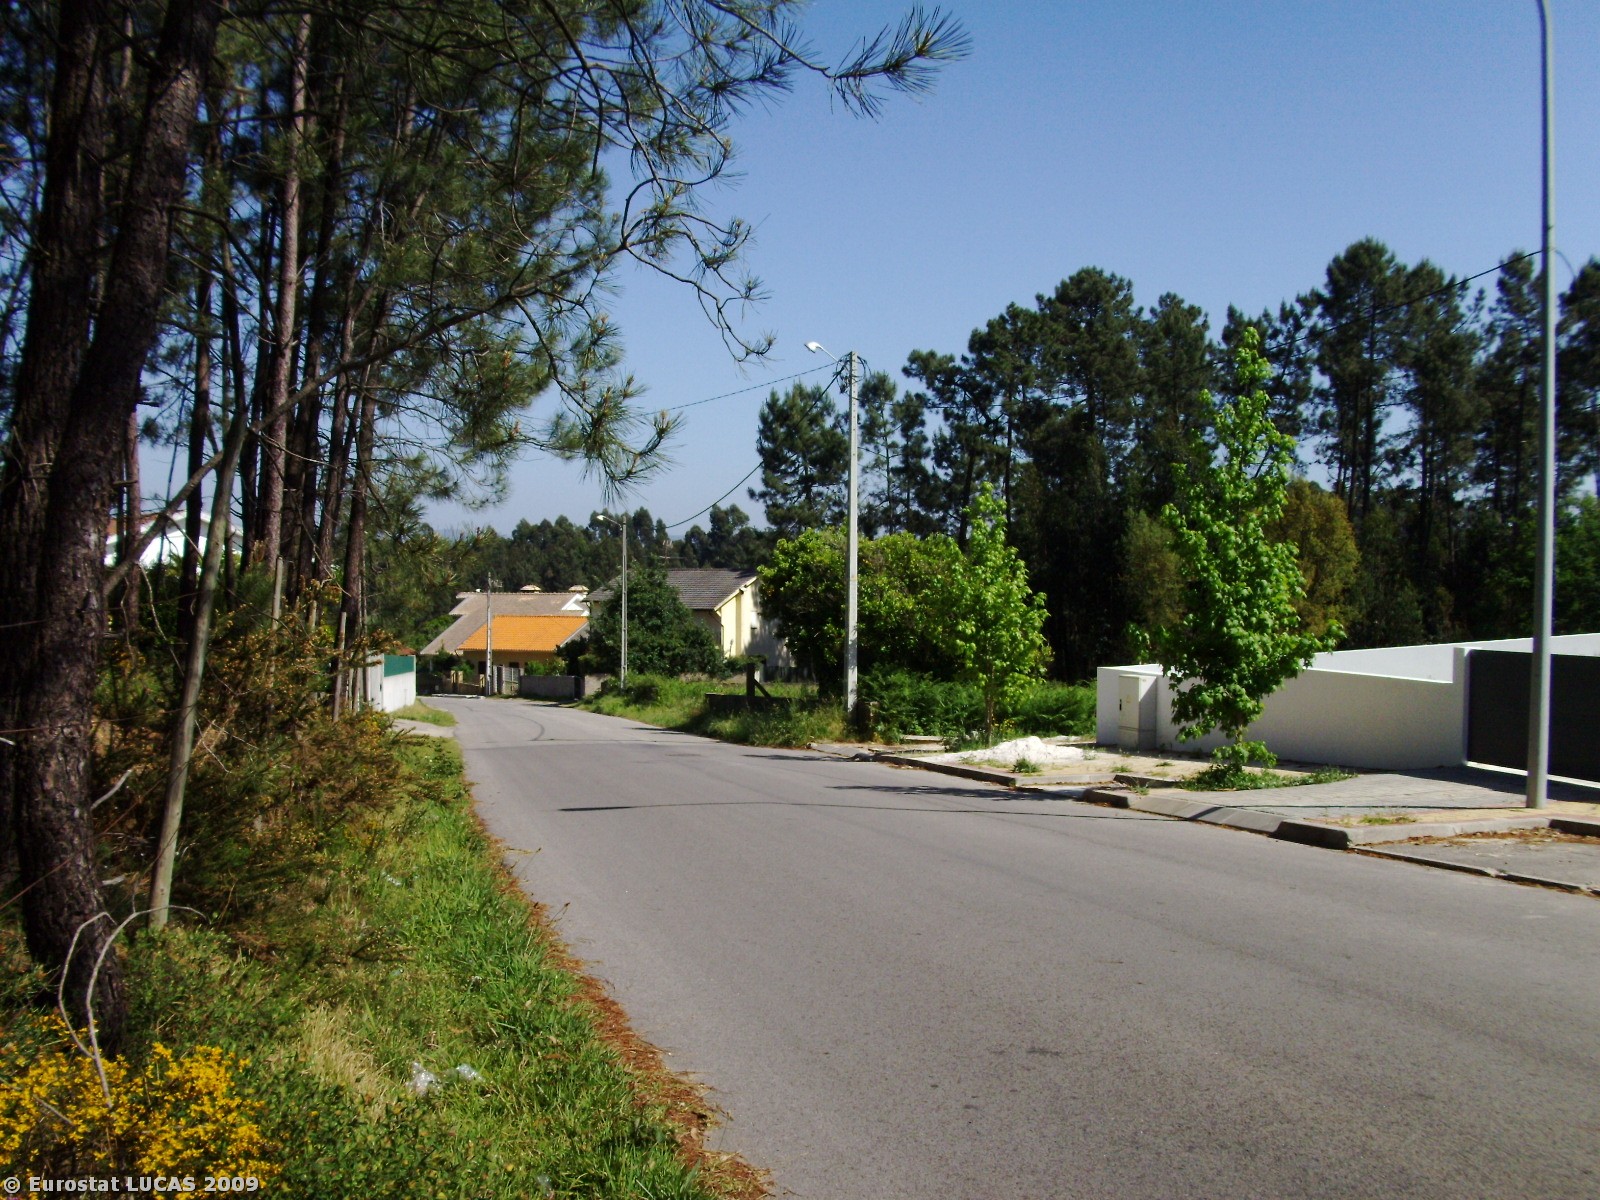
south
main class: Woodland
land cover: Coniferous woodland
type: coniferous forest of the mediterranean region
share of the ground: > 75 %
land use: Forestry
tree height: > 5 m
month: May
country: PT
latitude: 40.6096
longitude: -8.4460
